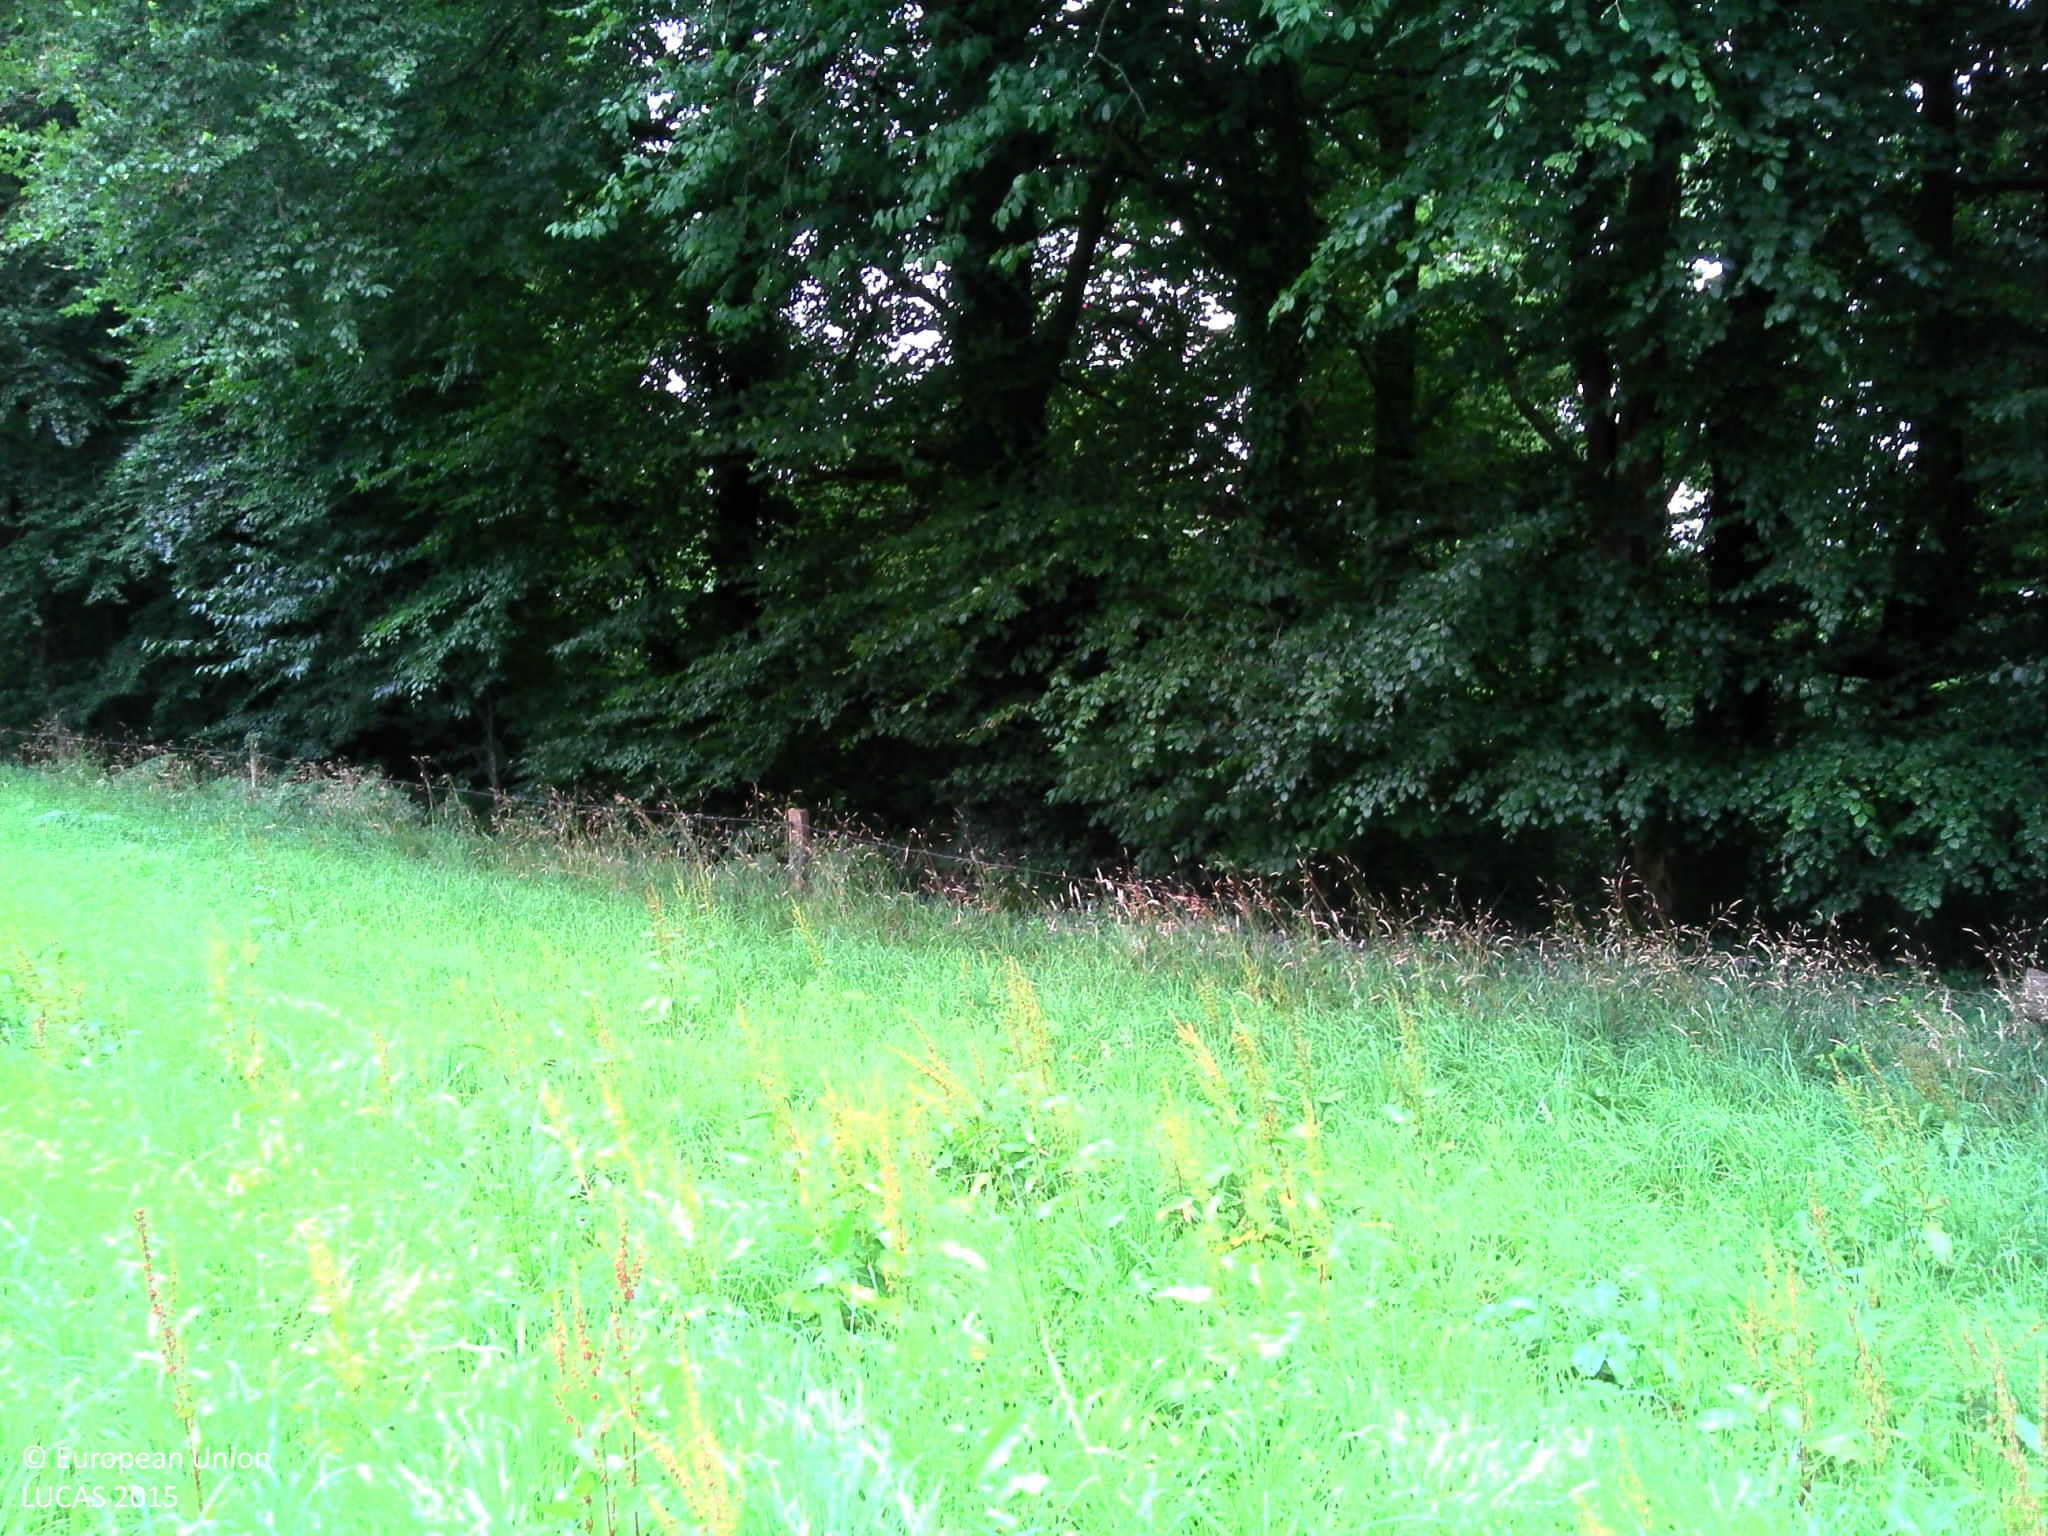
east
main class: Grassland
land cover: Grassland without tree/shrub cover
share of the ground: > 75 %
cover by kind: herbaceous plants 100 %
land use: Agriculture (excluding fallow land and kitchen gardens)
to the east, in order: Grassland without tree/shrub cover; Fences; Broadleaved woodland; Tracks; Broadleaved woodland; Inland fresh water bodies
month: July
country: FR
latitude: 48.8914
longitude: -1.3254
